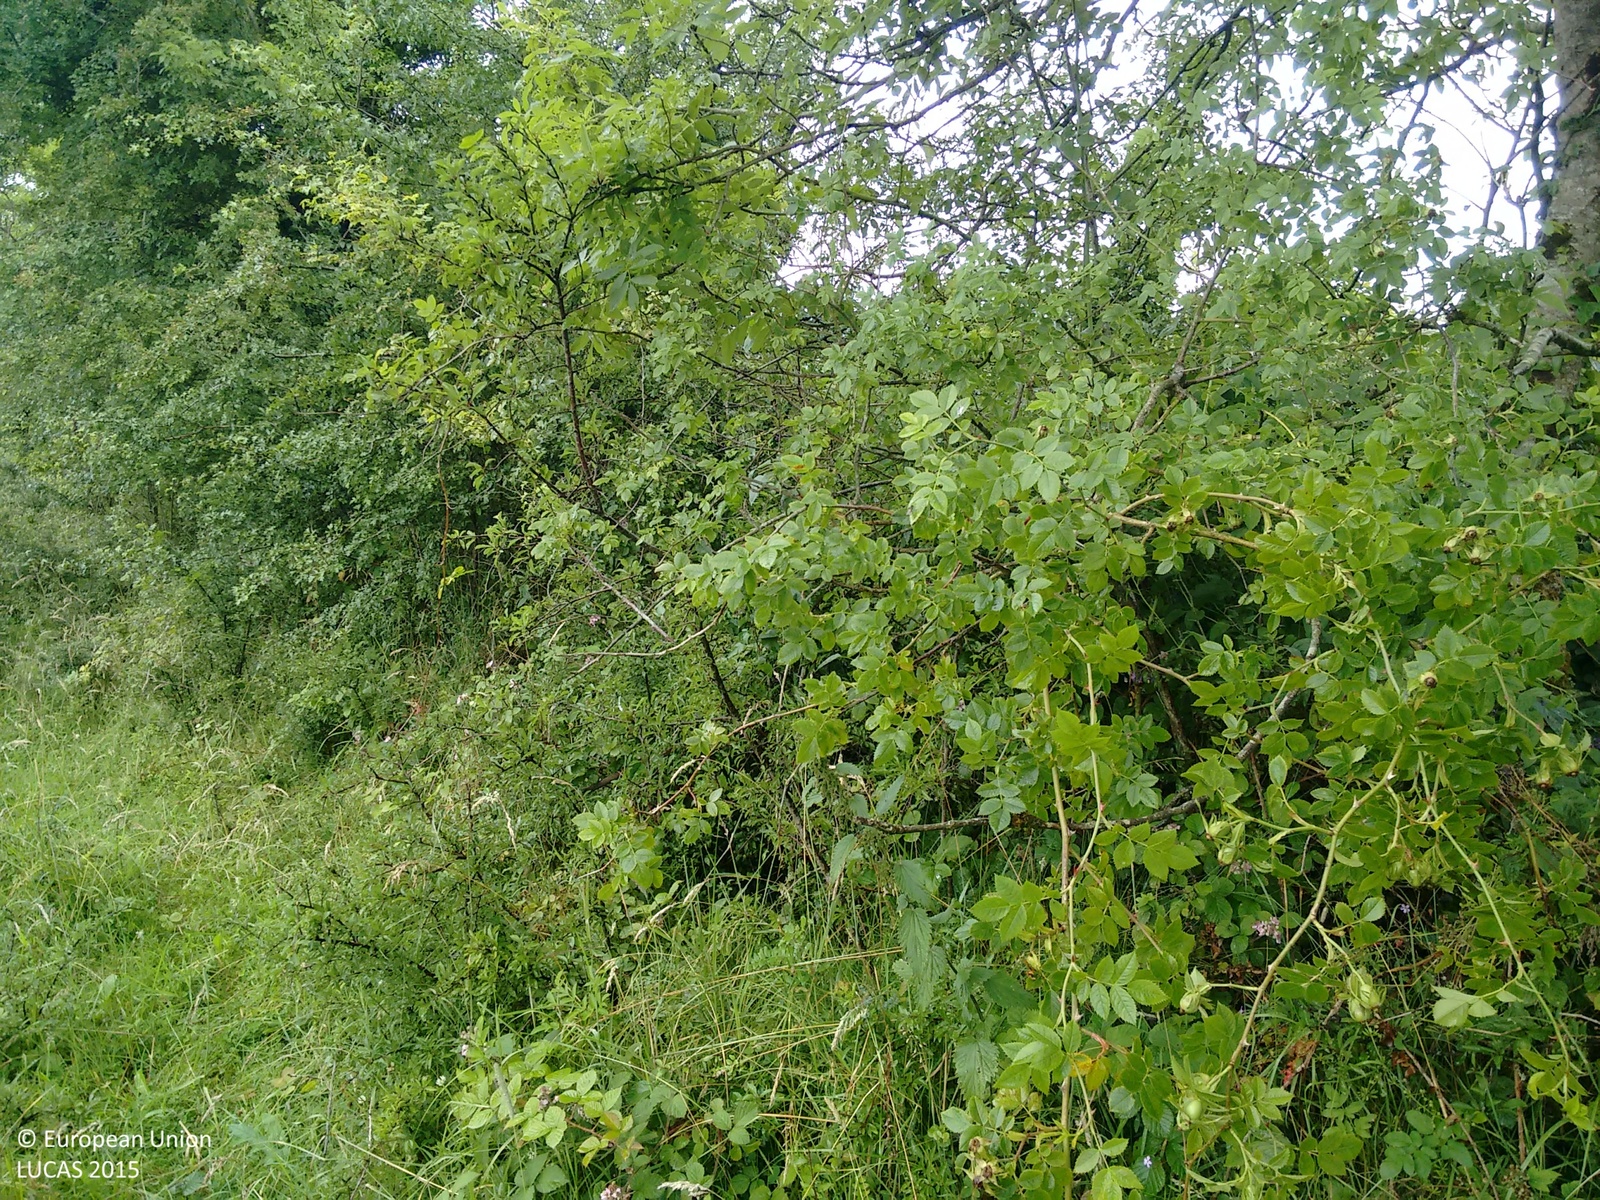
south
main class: Grassland
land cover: Grassland without tree/shrub cover
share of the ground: > 75 %
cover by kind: herbaceous plants 95 %, shrubs 5 %
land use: Agriculture (excluding fallow land and kitchen gardens)
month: July
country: IE
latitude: 53.7495
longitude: -7.8987
